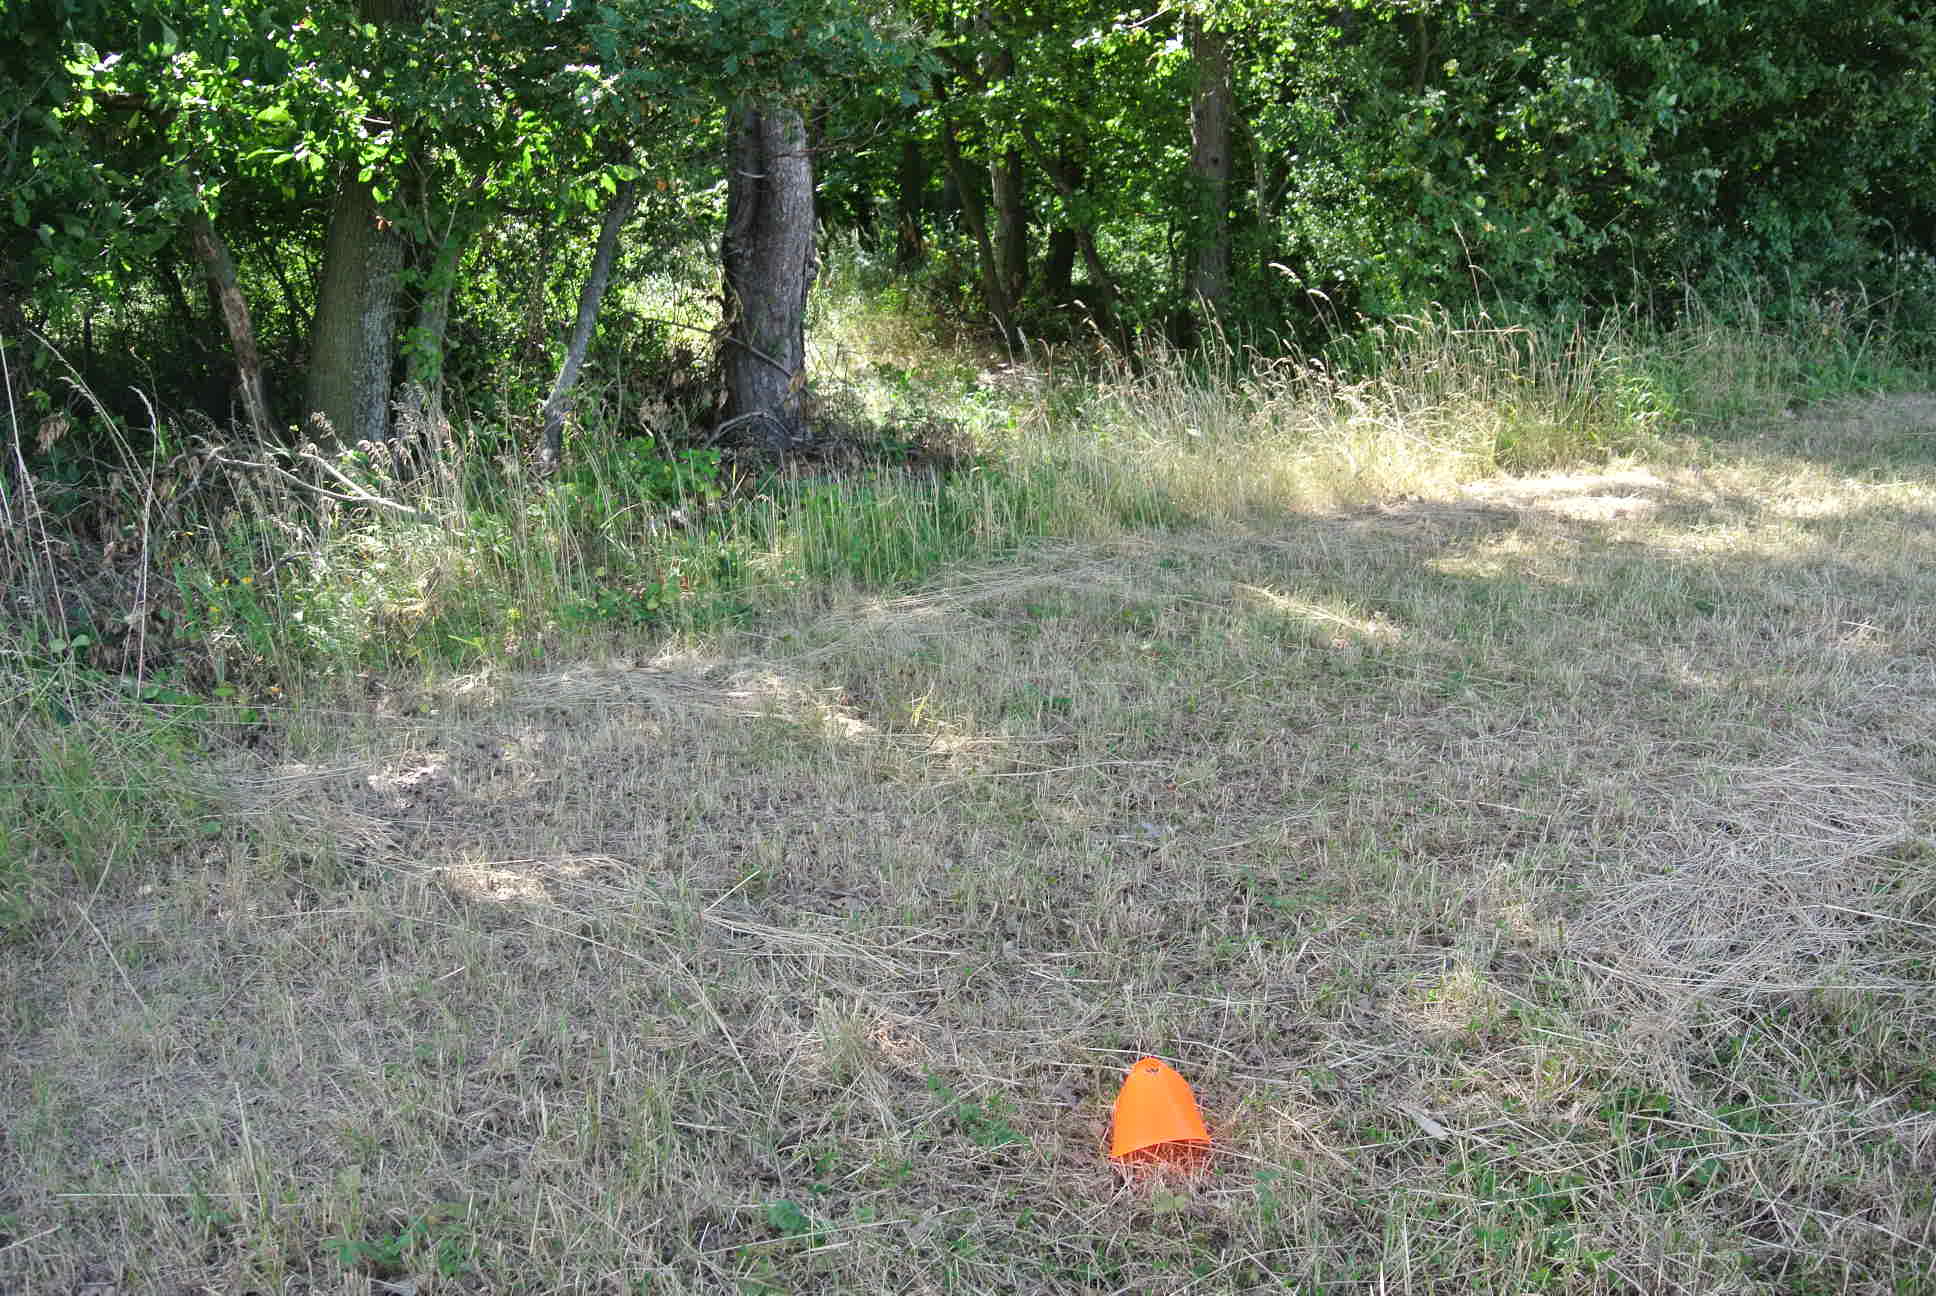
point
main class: Grassland
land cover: Grassland without tree/shrub cover
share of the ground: > 75 %
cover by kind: herbaceous plants 100 %
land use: Agriculture (excluding fallow land and kitchen gardens)
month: July
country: AT
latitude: 47.7444
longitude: 16.4728
